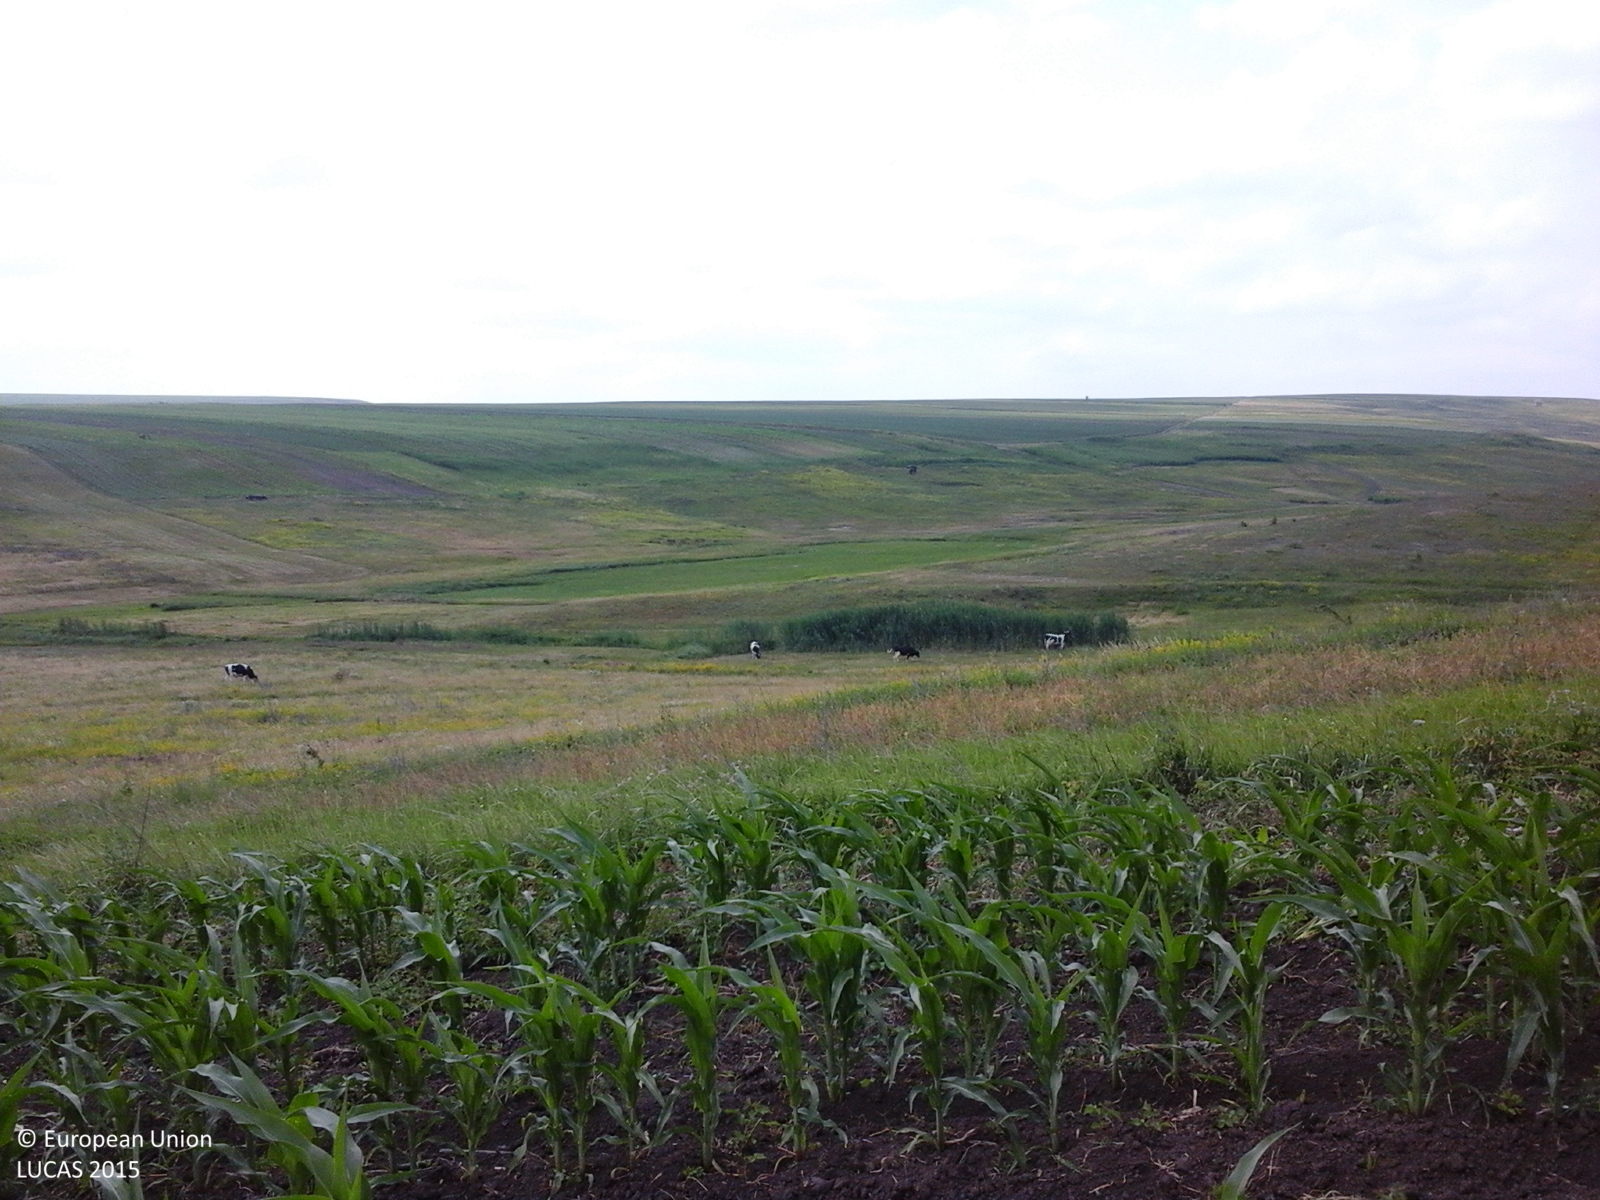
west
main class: Cropland
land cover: Maize
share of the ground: 25 - 50 %
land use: Agriculture (excluding fallow land and kitchen gardens)
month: June
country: RO
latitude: 48.0496
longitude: 26.6374
